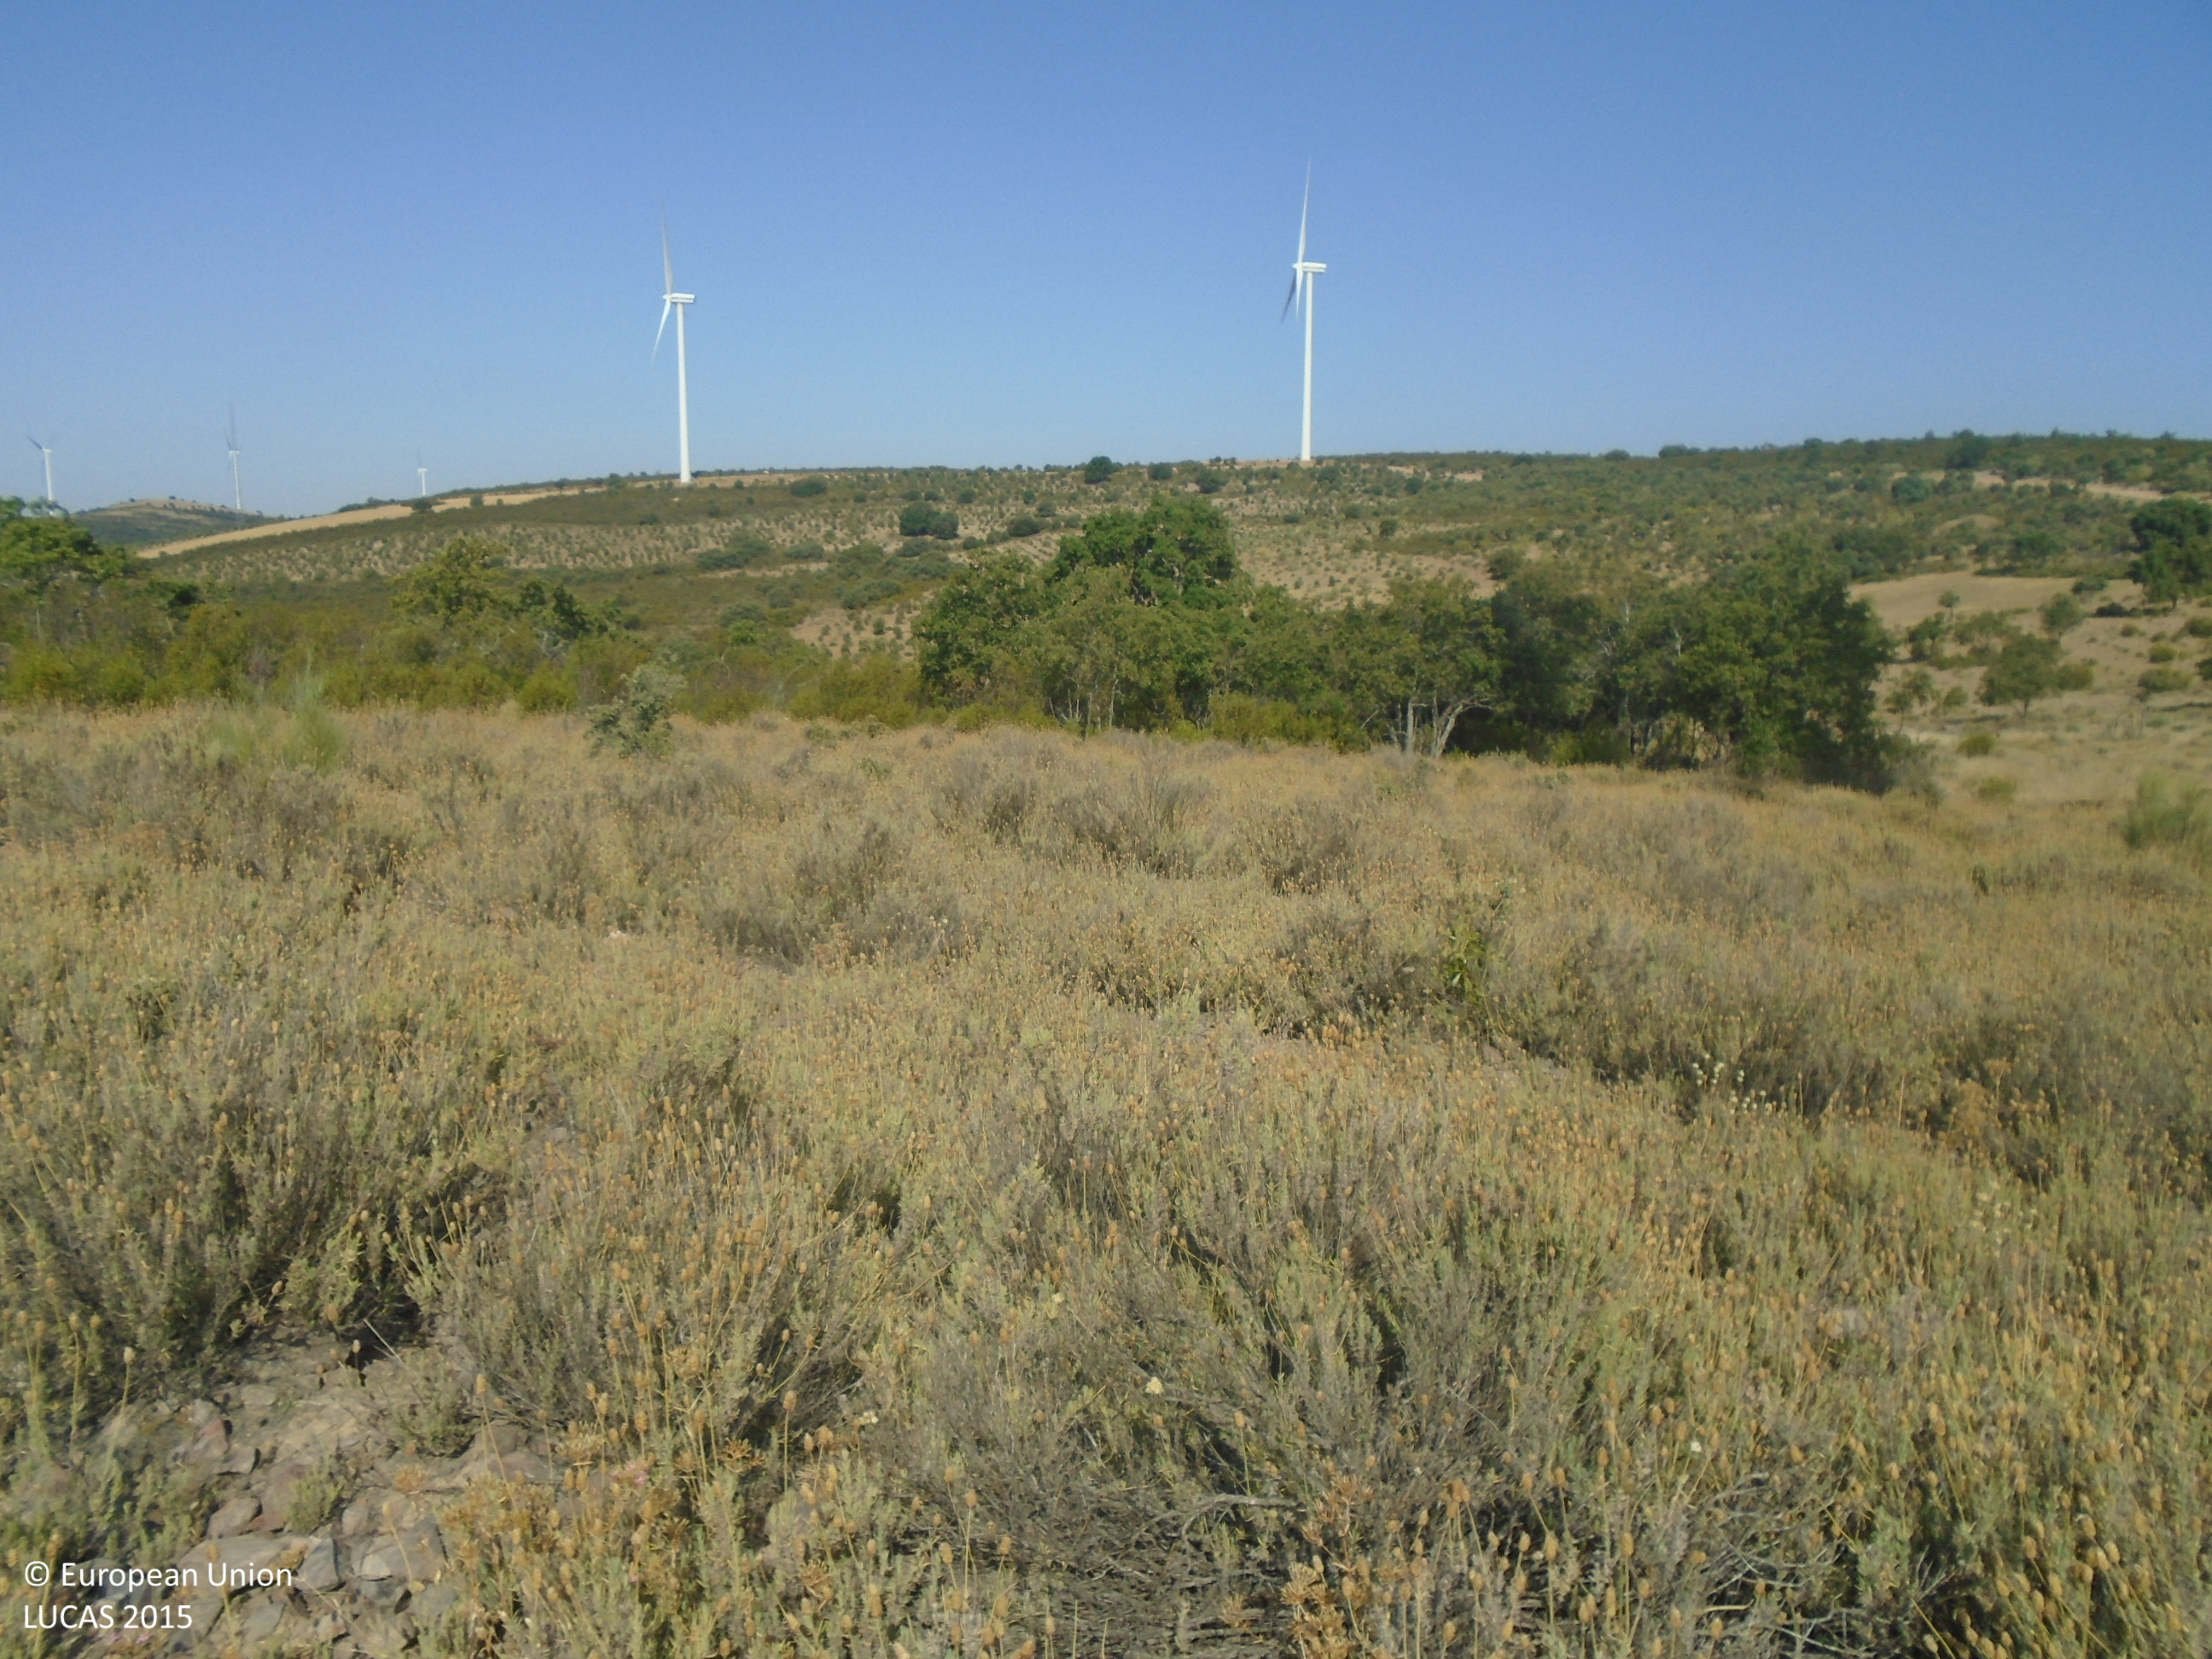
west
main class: Shrubland
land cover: Shrubland without tree cover
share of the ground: > 75 %
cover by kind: shrubs 100 %
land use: Agriculture (excluding fallow land and kitchen gardens)
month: July
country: ES
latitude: 39.2850
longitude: -4.0662
